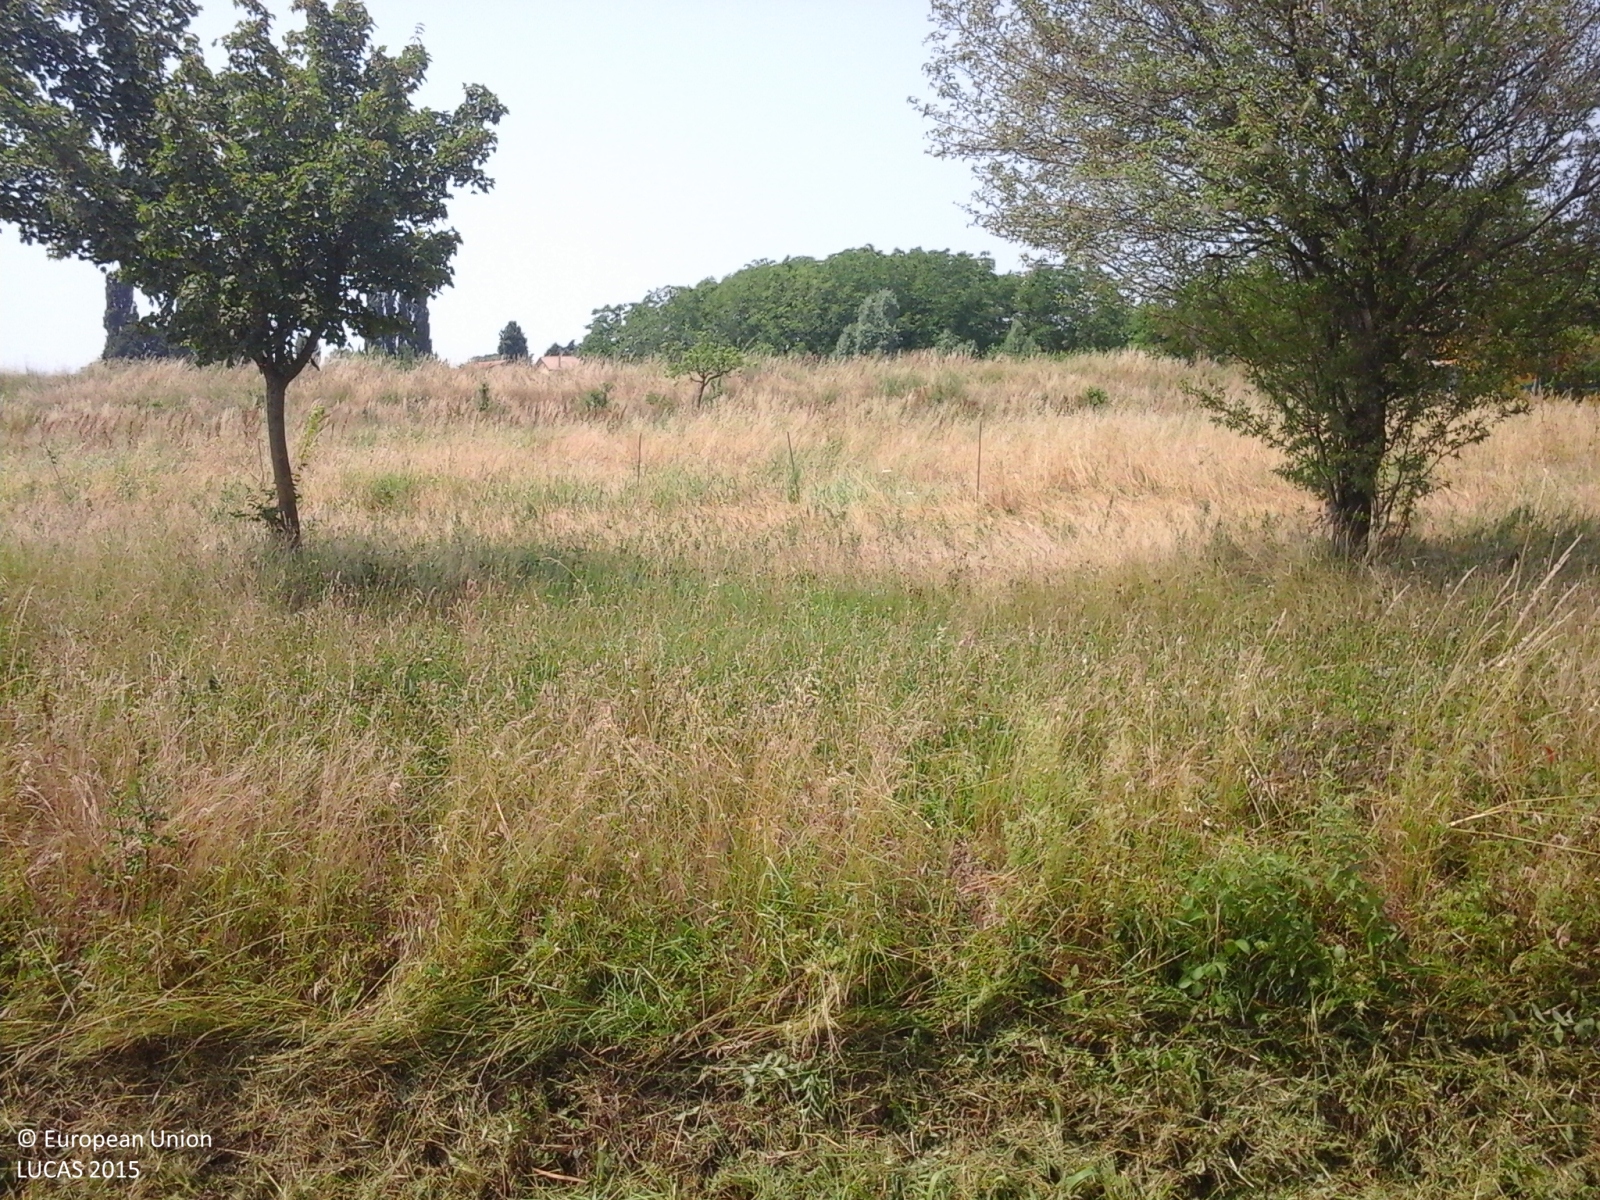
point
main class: Grassland
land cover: Grassland with sparse tree/shrub cover
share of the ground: > 75 %
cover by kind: herbaceous plants 95 %, broadleaved forest trees 5 %
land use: Agriculture (excluding fallow land and kitchen gardens)
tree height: < 5 m
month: June
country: IT
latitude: 45.6023
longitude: 12.4452
